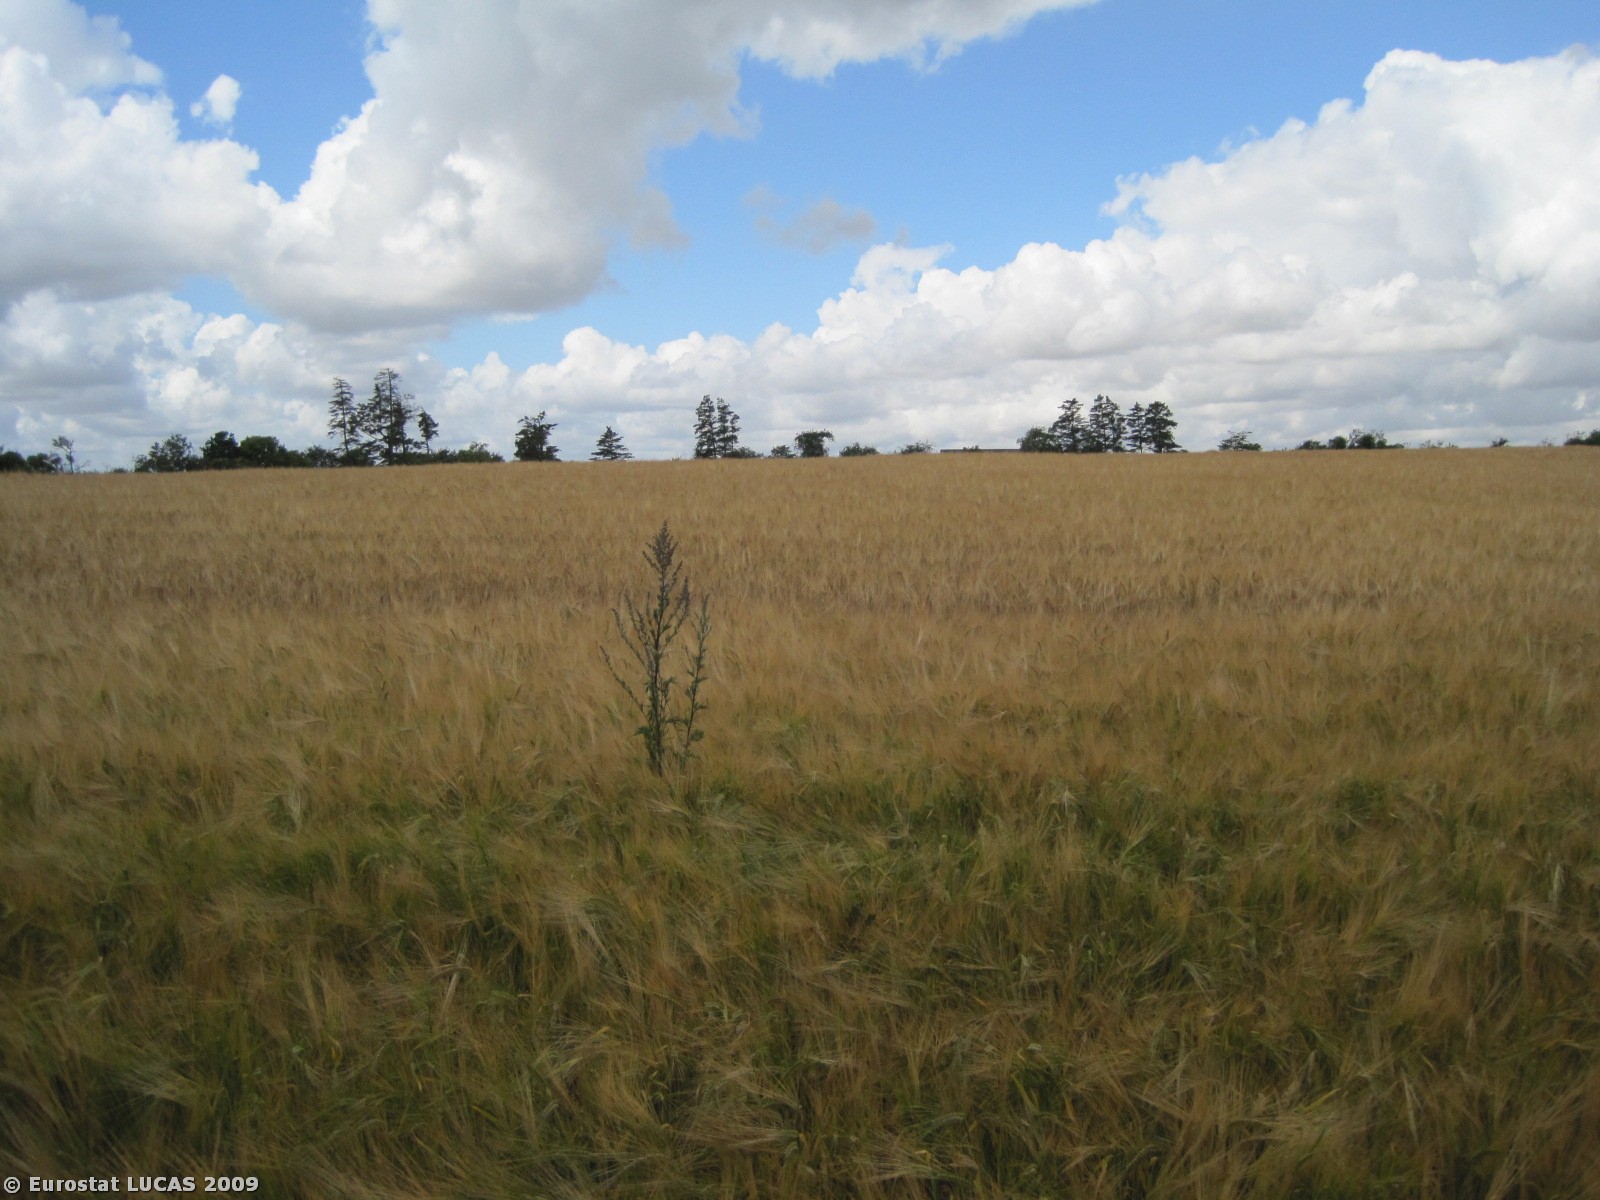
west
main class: Cropland
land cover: Barley
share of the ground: > 75 %
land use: Agriculture (excluding fallow land and kitchen gardens)
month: July
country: DK
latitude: 56.3804
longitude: 8.8516
